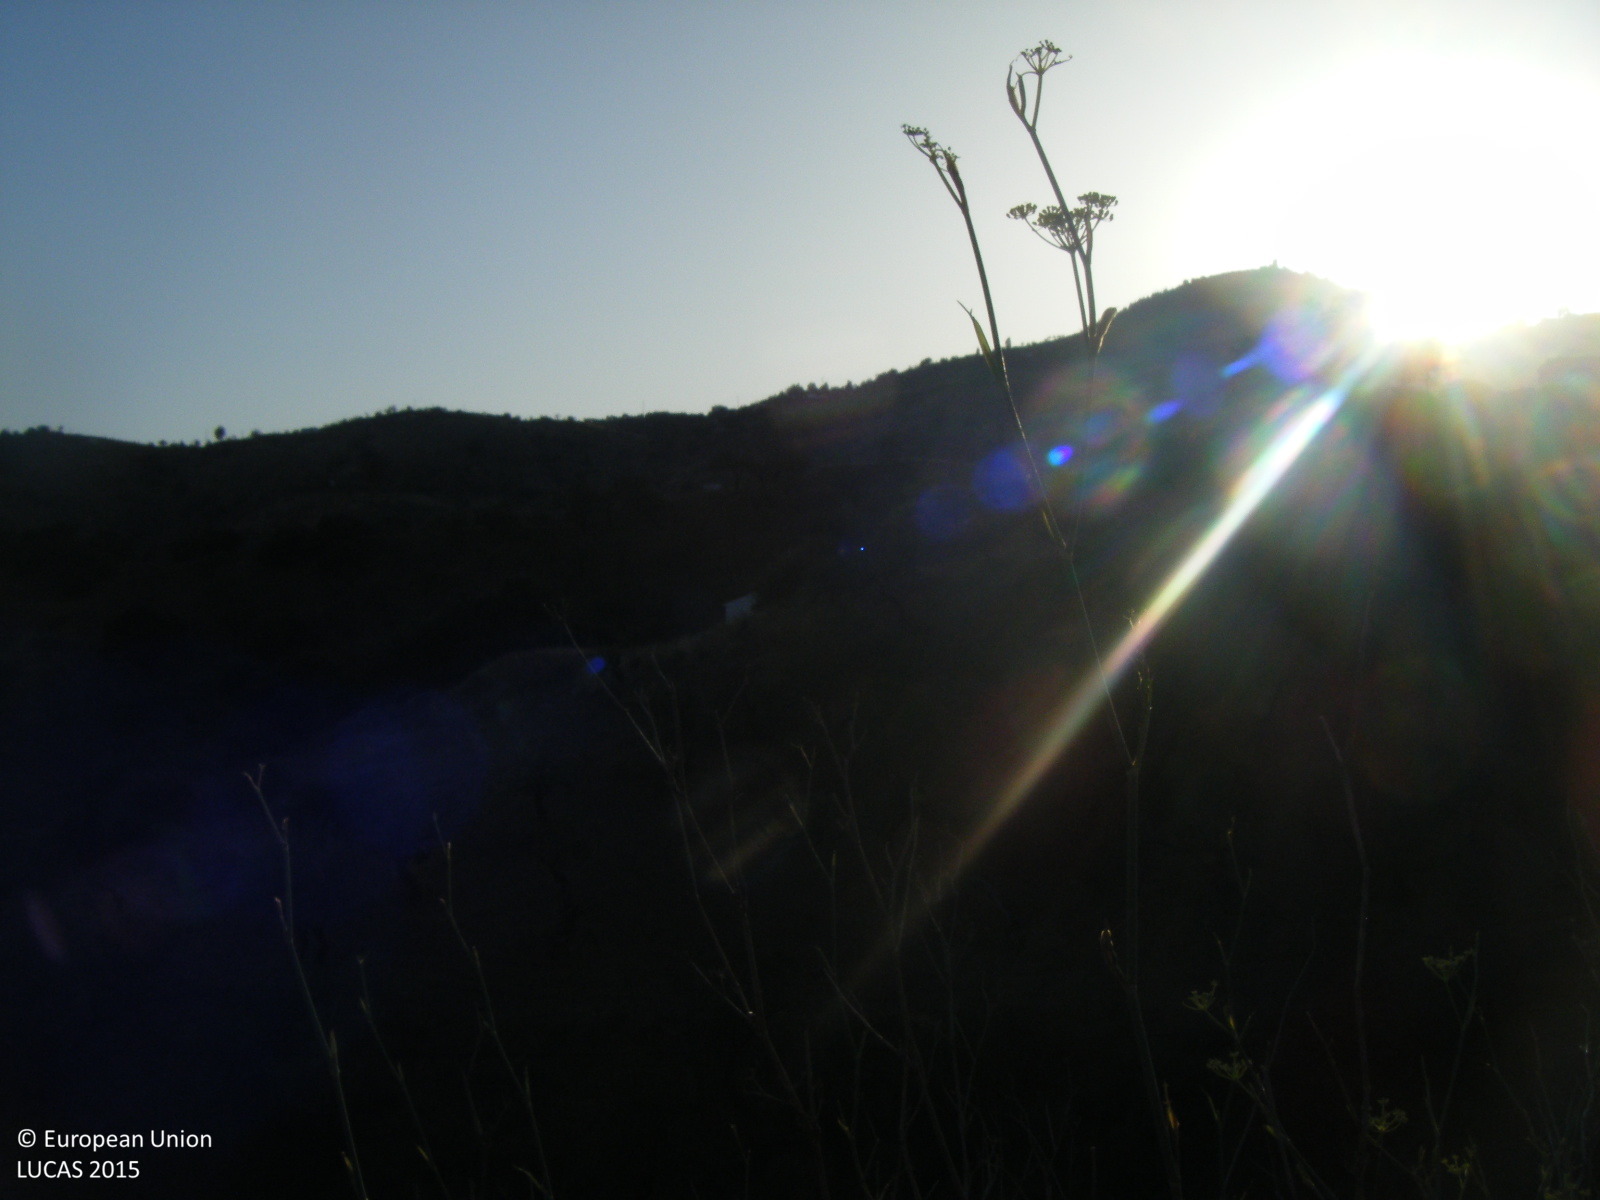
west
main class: Grassland
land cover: Grassland without tree/shrub cover
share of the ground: > 75 %
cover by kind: herbaceous plants 100 %
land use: Semi-natural and natural areas not in use
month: July
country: ES
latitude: 36.8794
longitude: -4.4321
